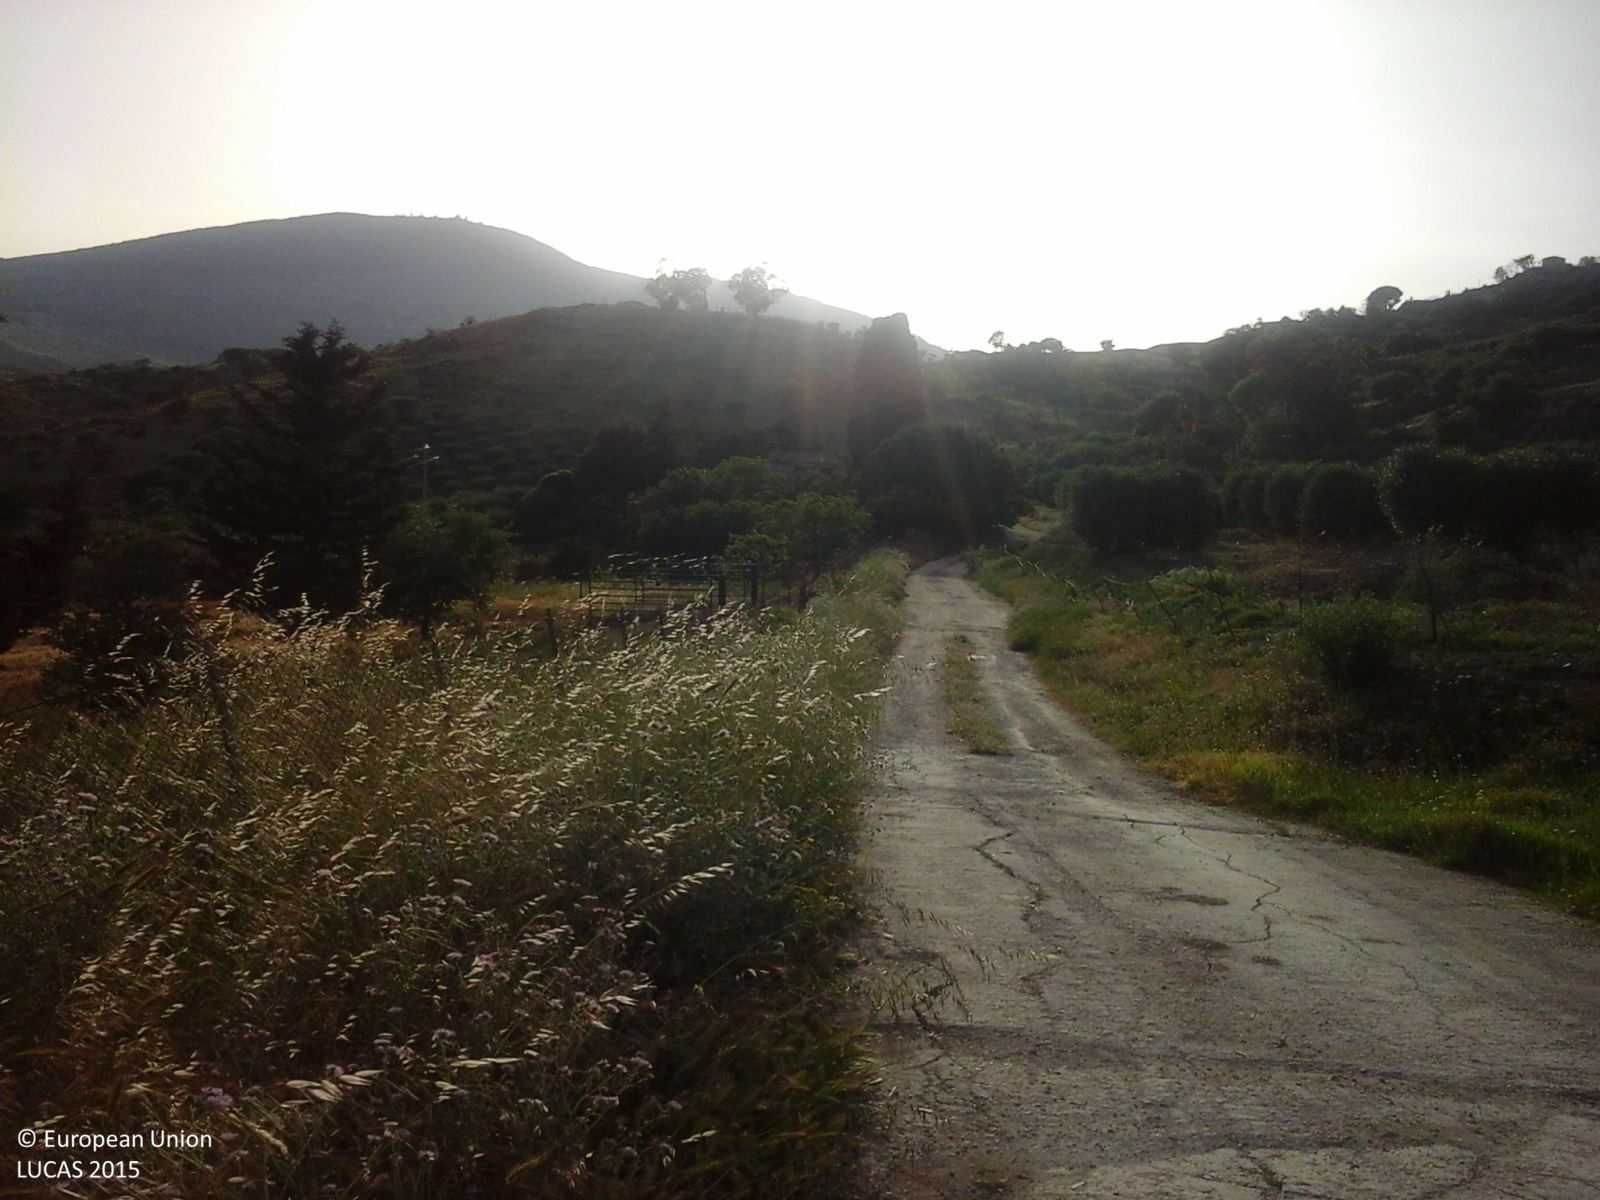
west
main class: Cropland
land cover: Durum wheat
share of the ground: > 75 %
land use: Agriculture (excluding fallow land and kitchen gardens)
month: May
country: IT
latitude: 37.6219
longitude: 13.6776
